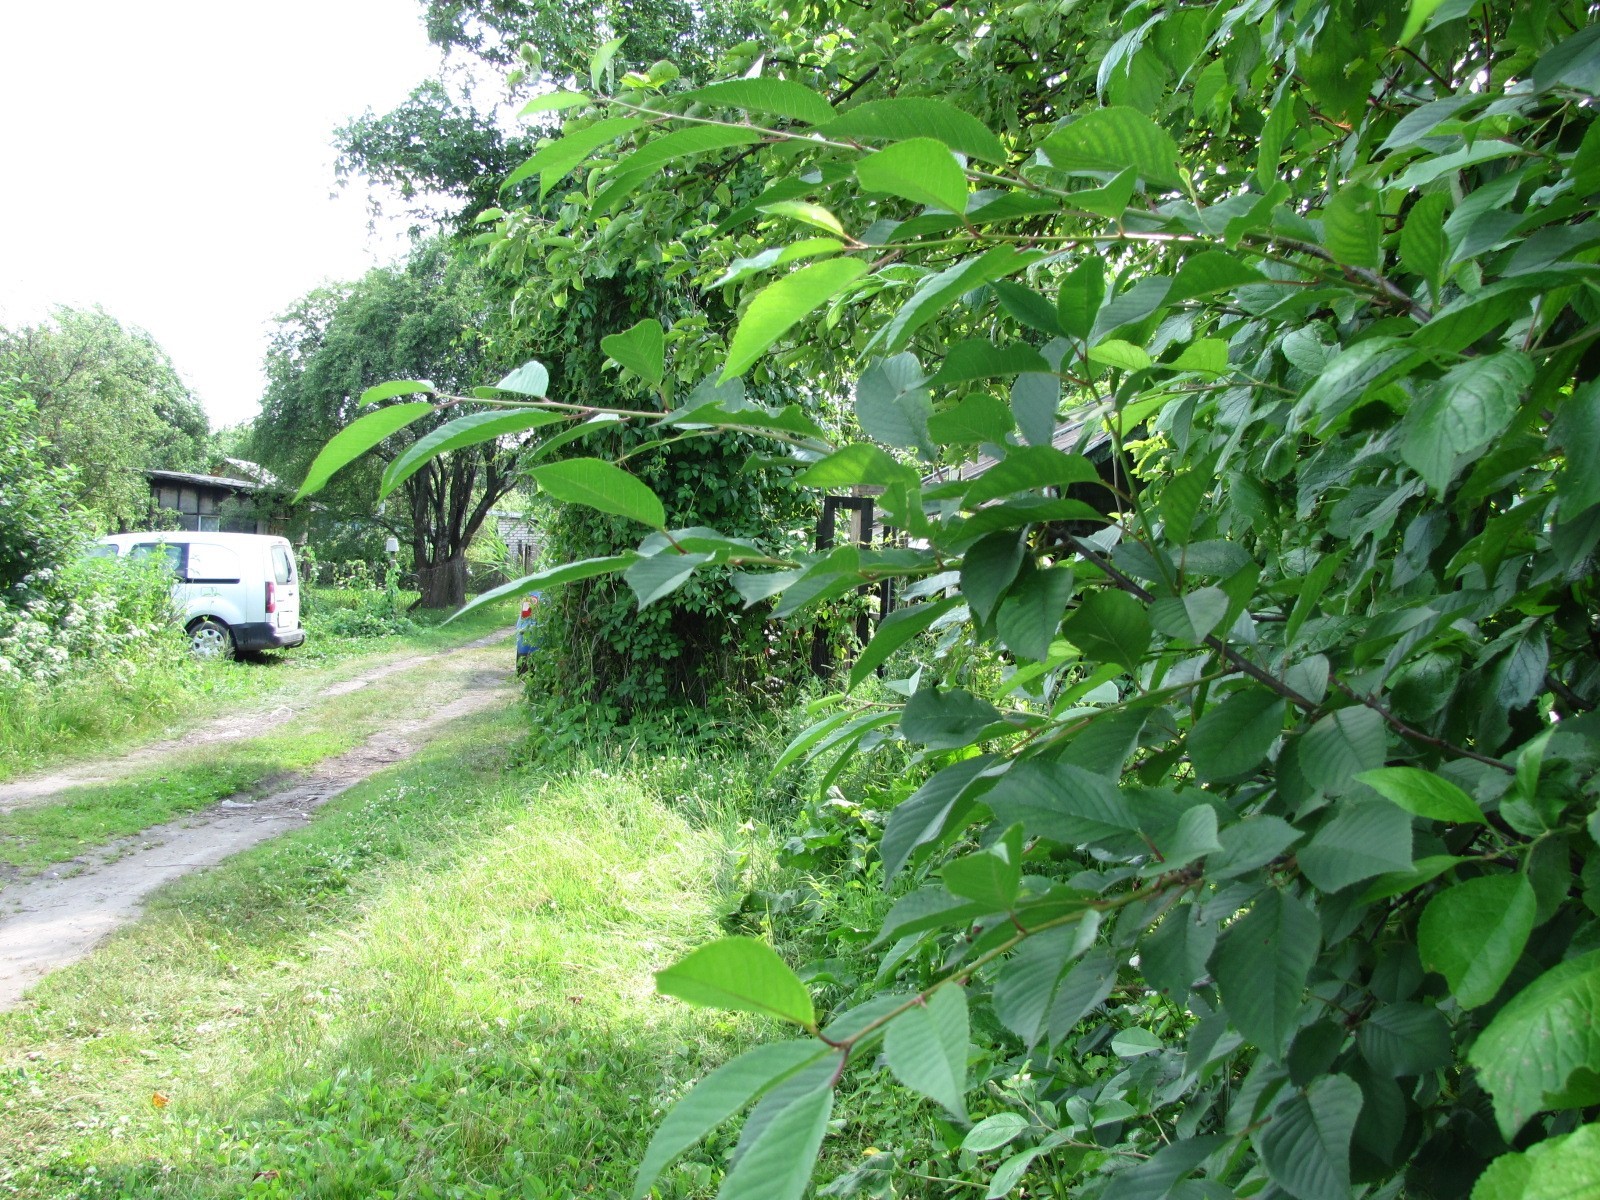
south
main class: Cropland
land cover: Cherry fruit
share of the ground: 50 - 75 %
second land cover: Grassland without tree/shrub cover
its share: > 75 %
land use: Kitchen garden
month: July
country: LV
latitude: 56.9185
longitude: 24.1309
